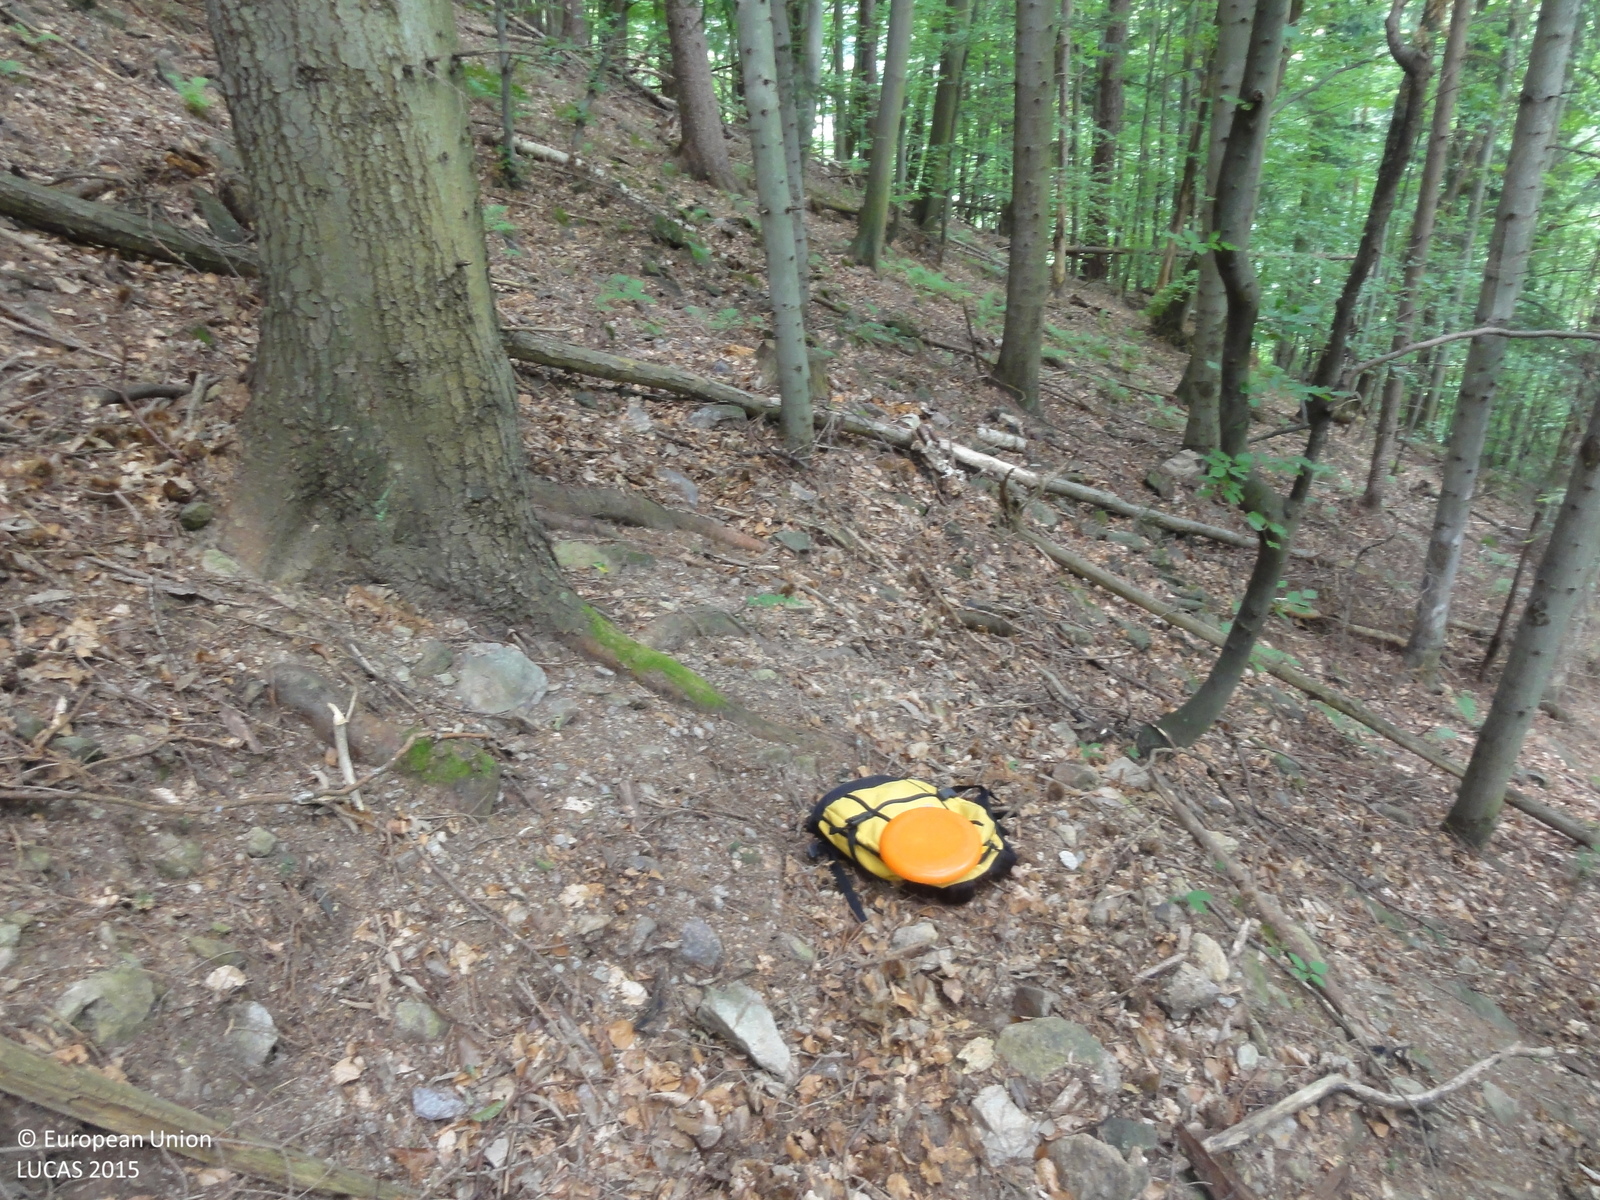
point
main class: Woodland
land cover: Spruce dominated mixed woodland
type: beech forest
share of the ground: > 75 %
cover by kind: broadleaved forest trees 60 %, coniferous forest trees 40 %
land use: Forestry
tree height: > 5 m
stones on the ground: 25 - 50 %
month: July
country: SI
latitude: 46.6030
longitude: 15.5735
